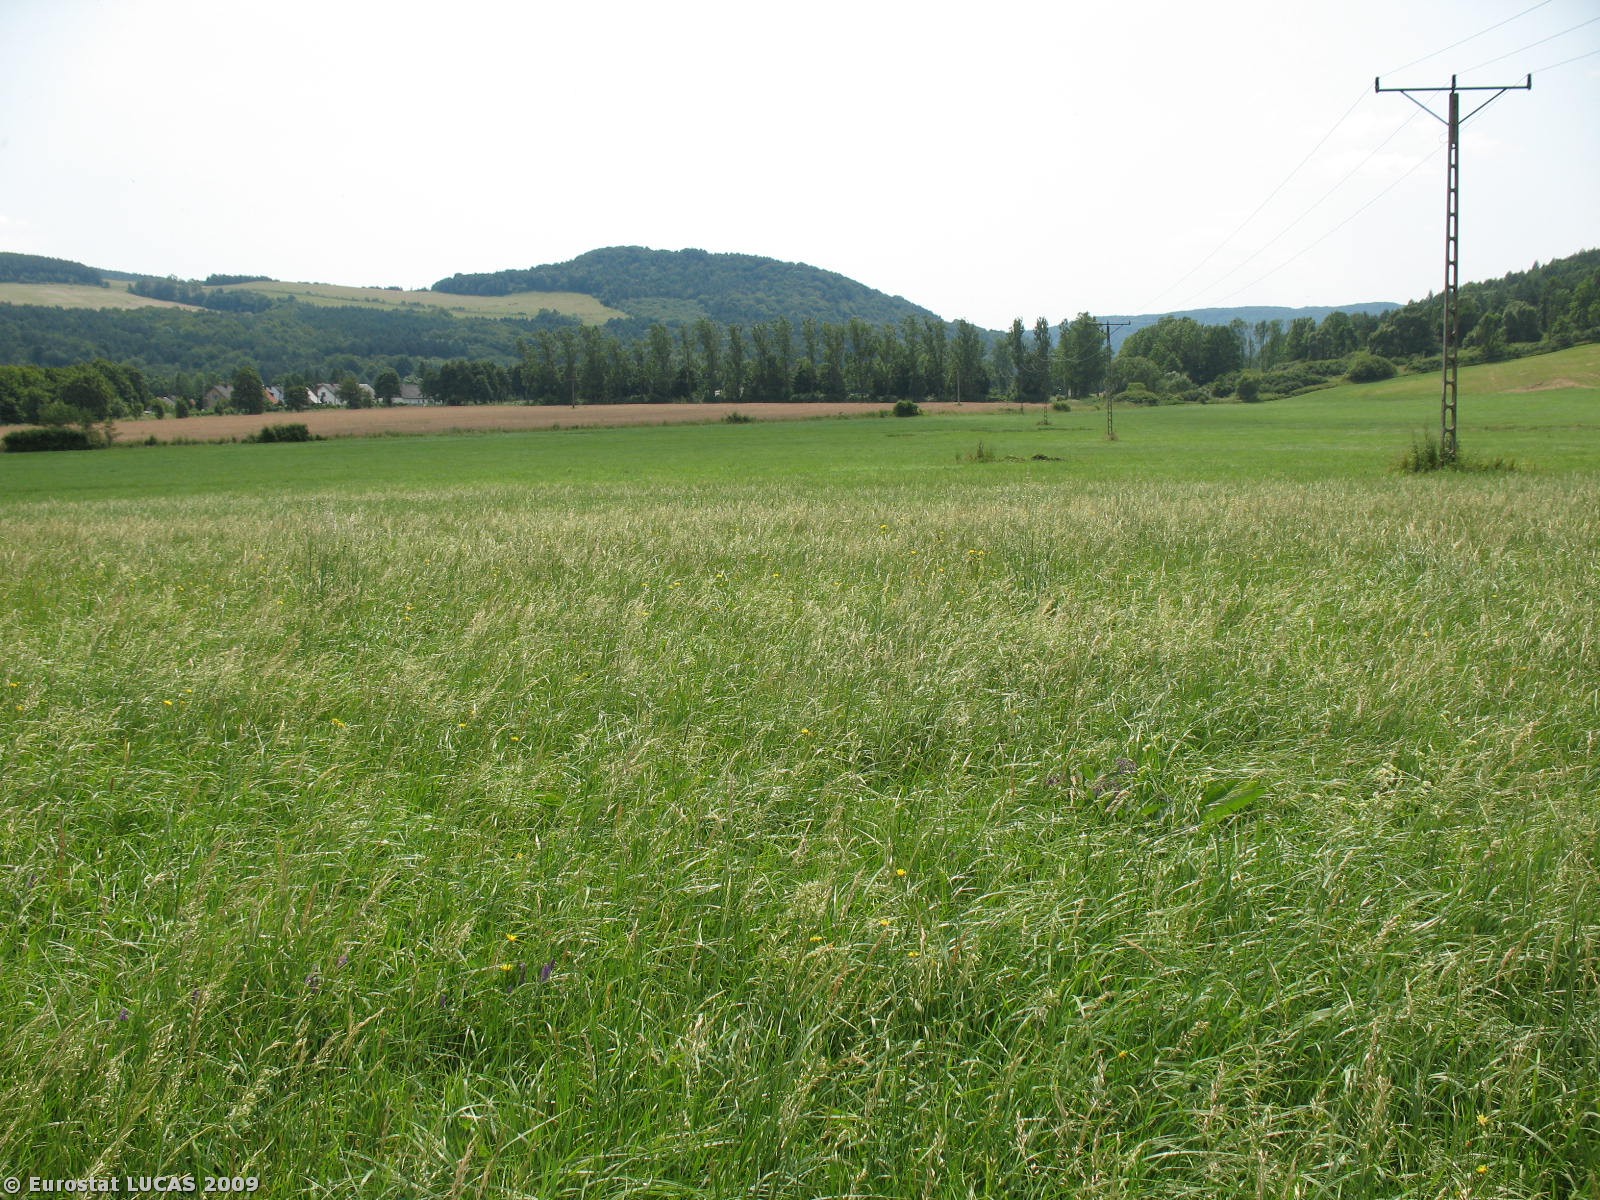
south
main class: Grassland
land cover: Grassland without tree/shrub cover
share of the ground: > 75 %
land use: Agriculture (excluding fallow land and kitchen gardens)
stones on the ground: < 10 %
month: July
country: PL
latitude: 49.5198
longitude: 21.9213
